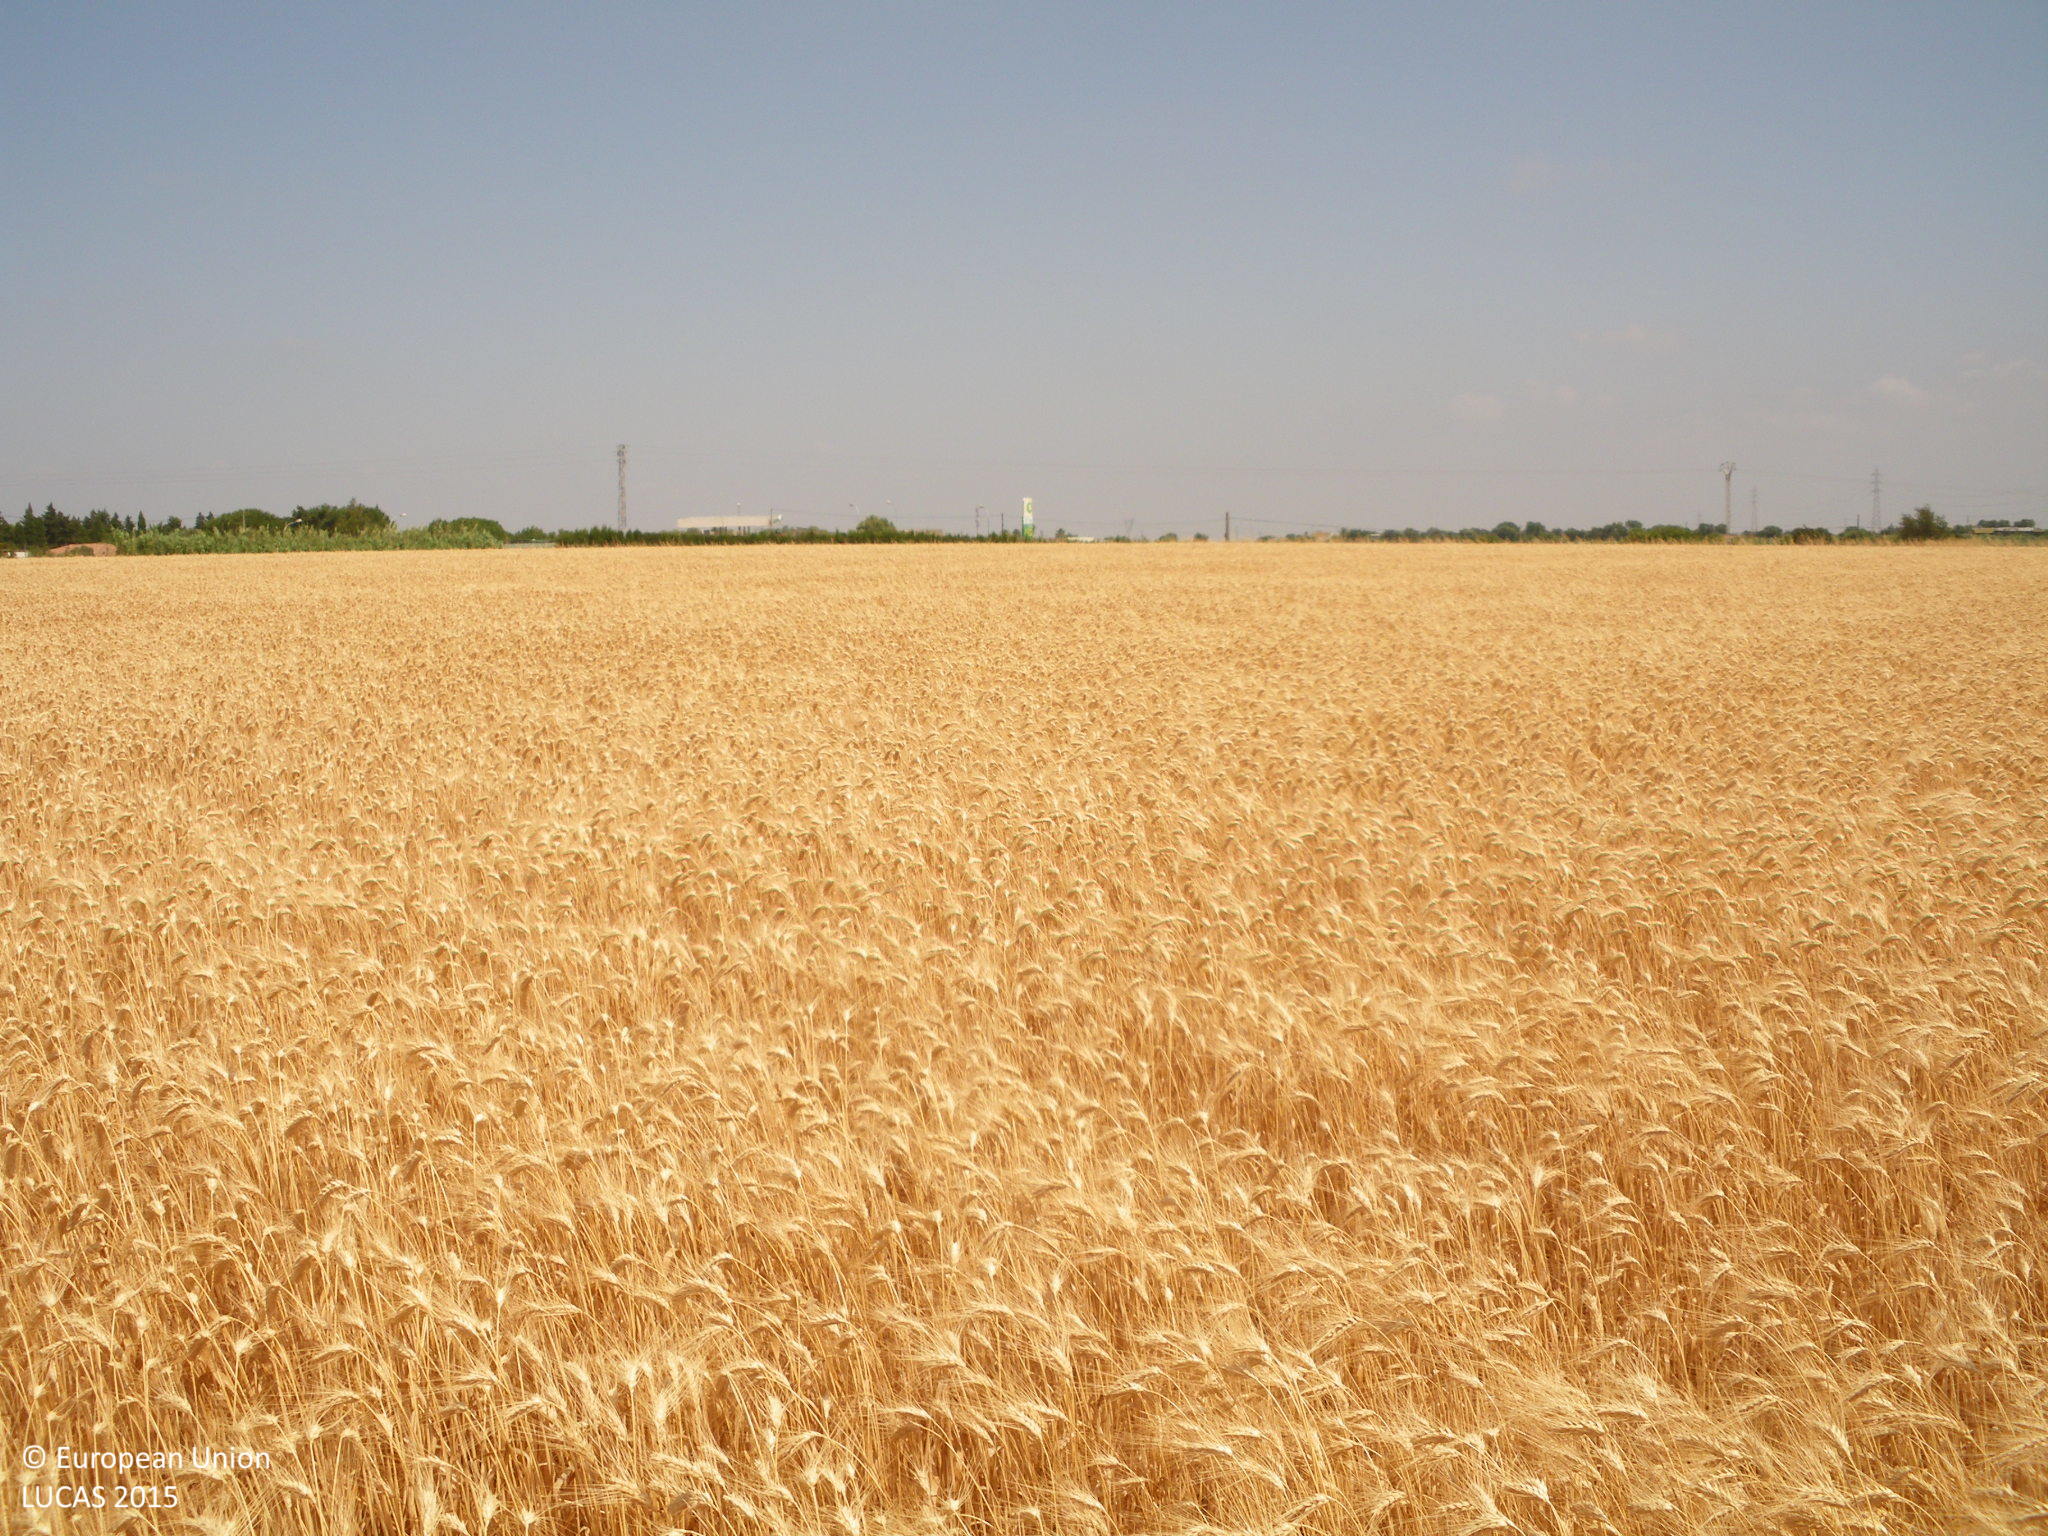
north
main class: Cropland
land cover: Durum wheat
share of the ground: > 75 %
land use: Agriculture (excluding fallow land and kitchen gardens)
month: May
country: ES
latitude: 36.5239
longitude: -6.1466
